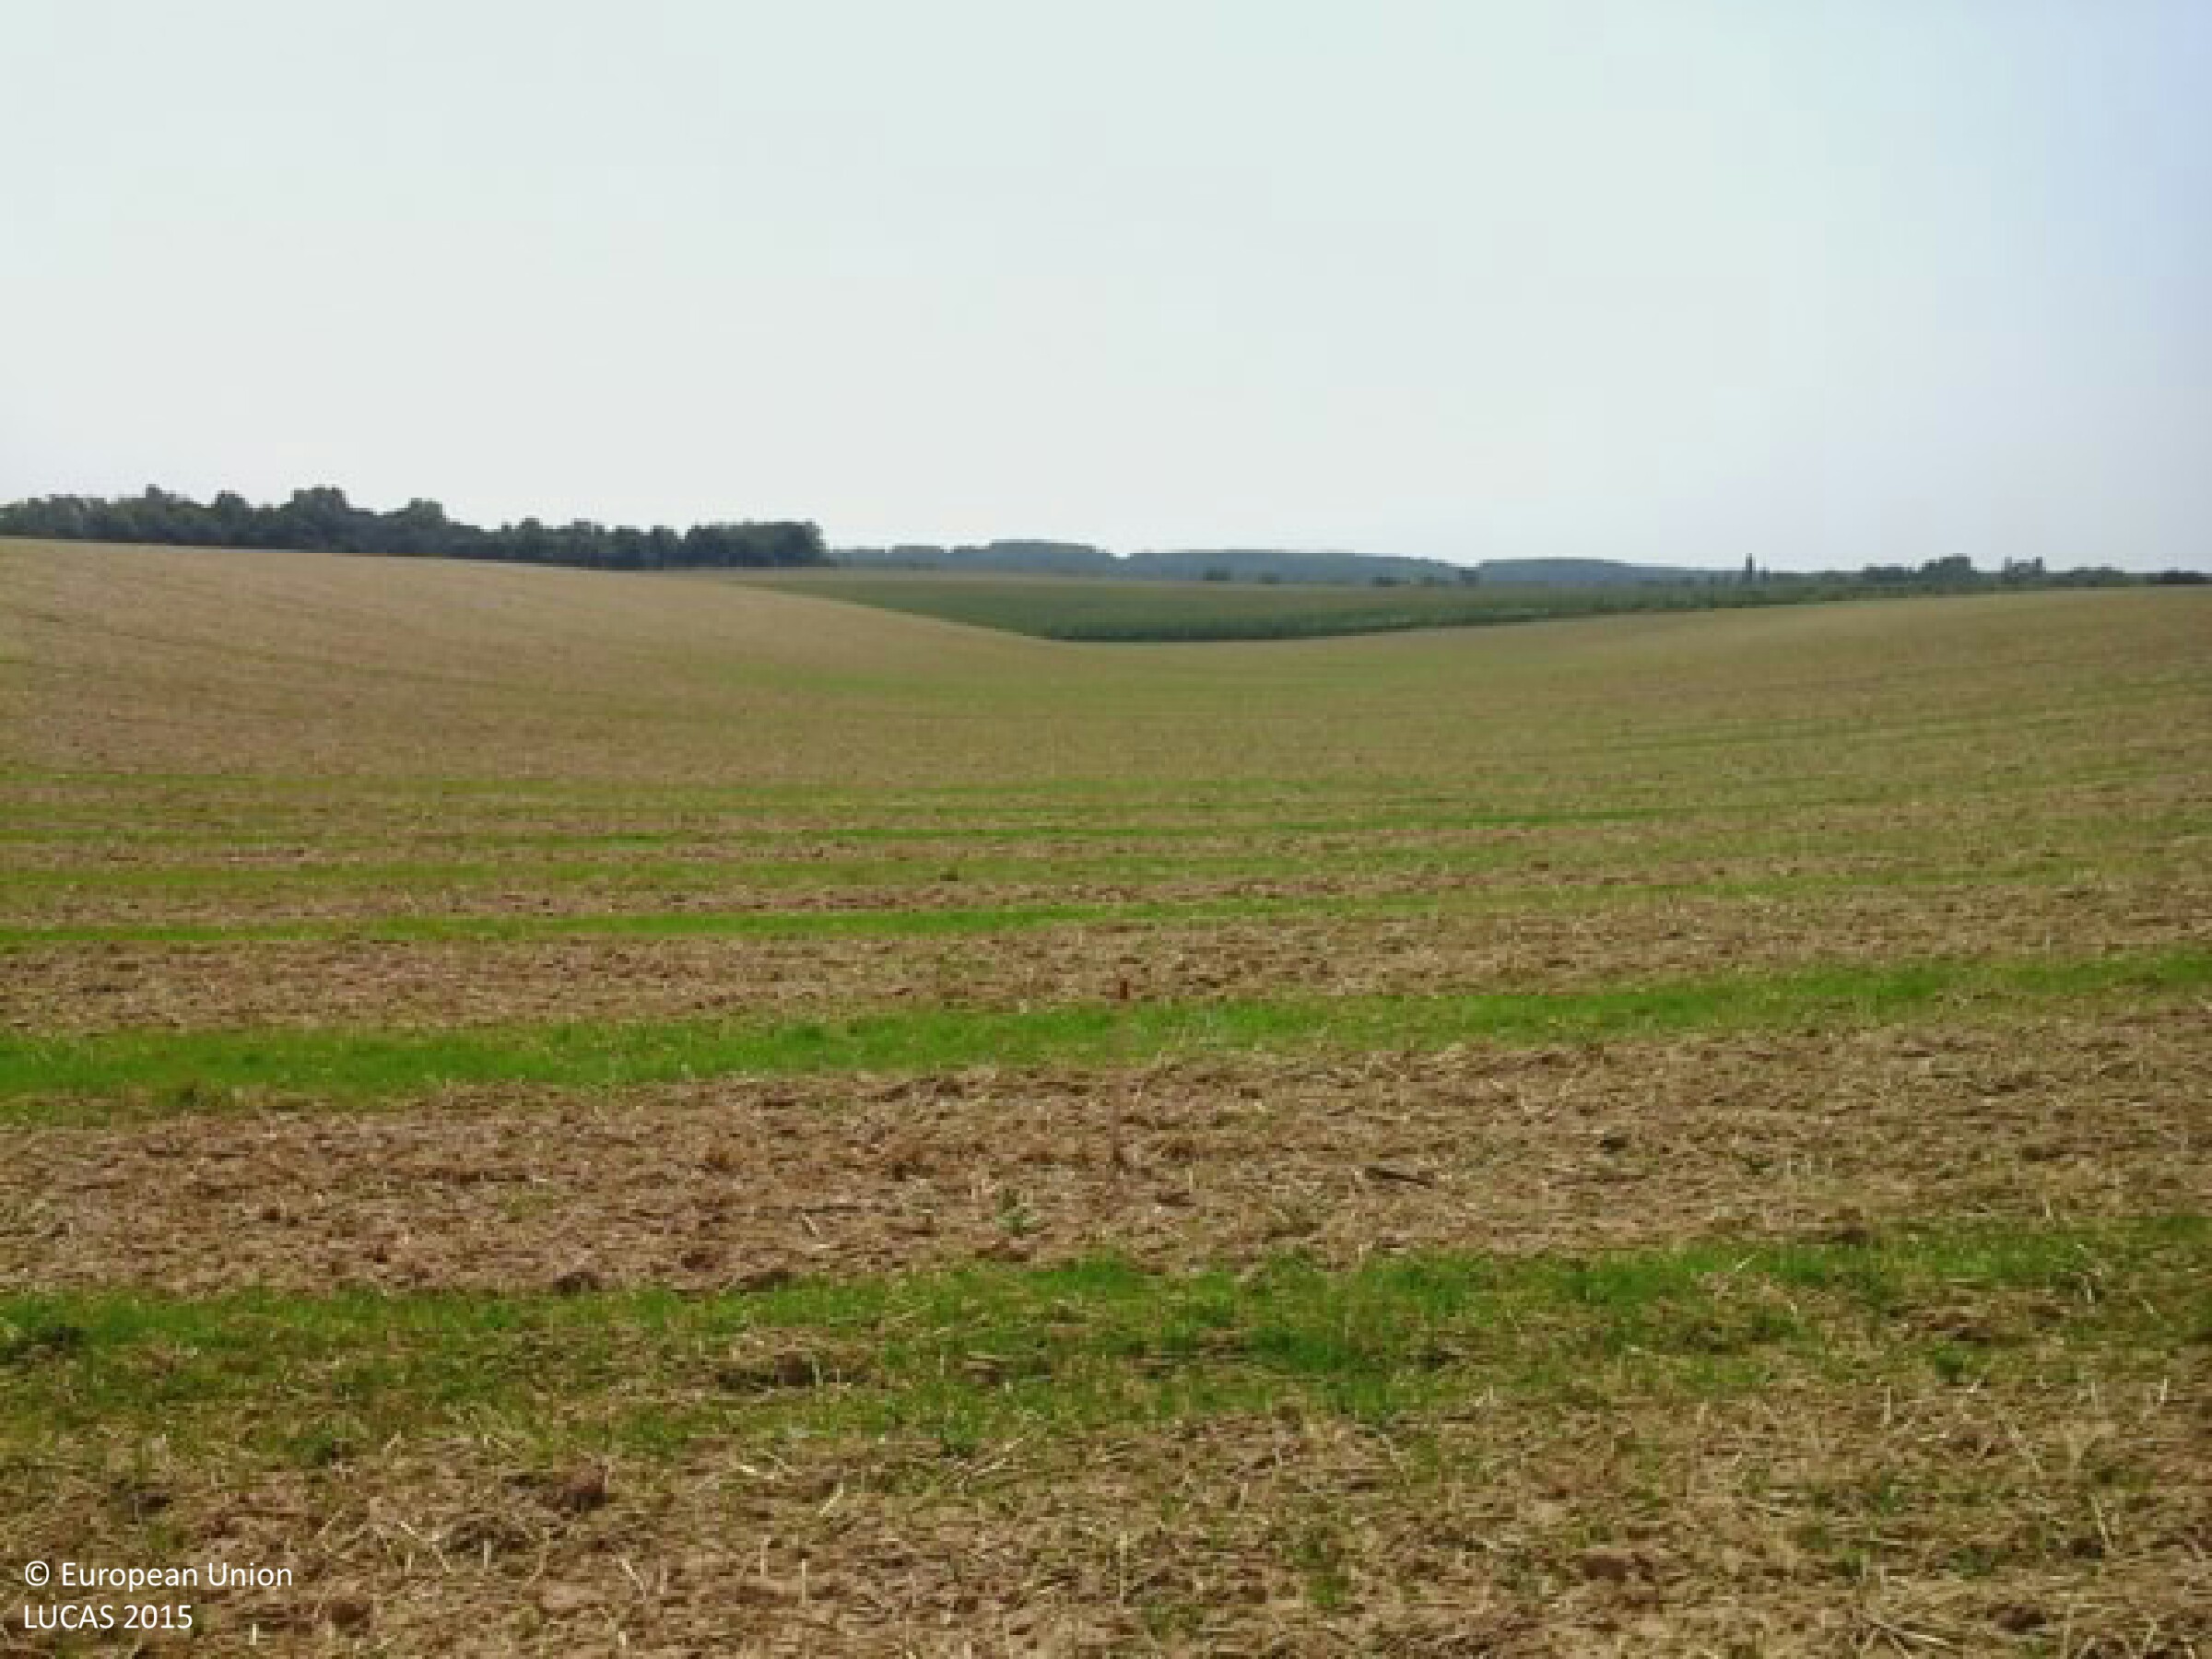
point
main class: Cropland
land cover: Common wheat
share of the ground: > 75 %
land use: Agriculture (excluding fallow land and kitchen gardens)
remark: Harvested field
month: August
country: HU
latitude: 46.5289
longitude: 17.3967
